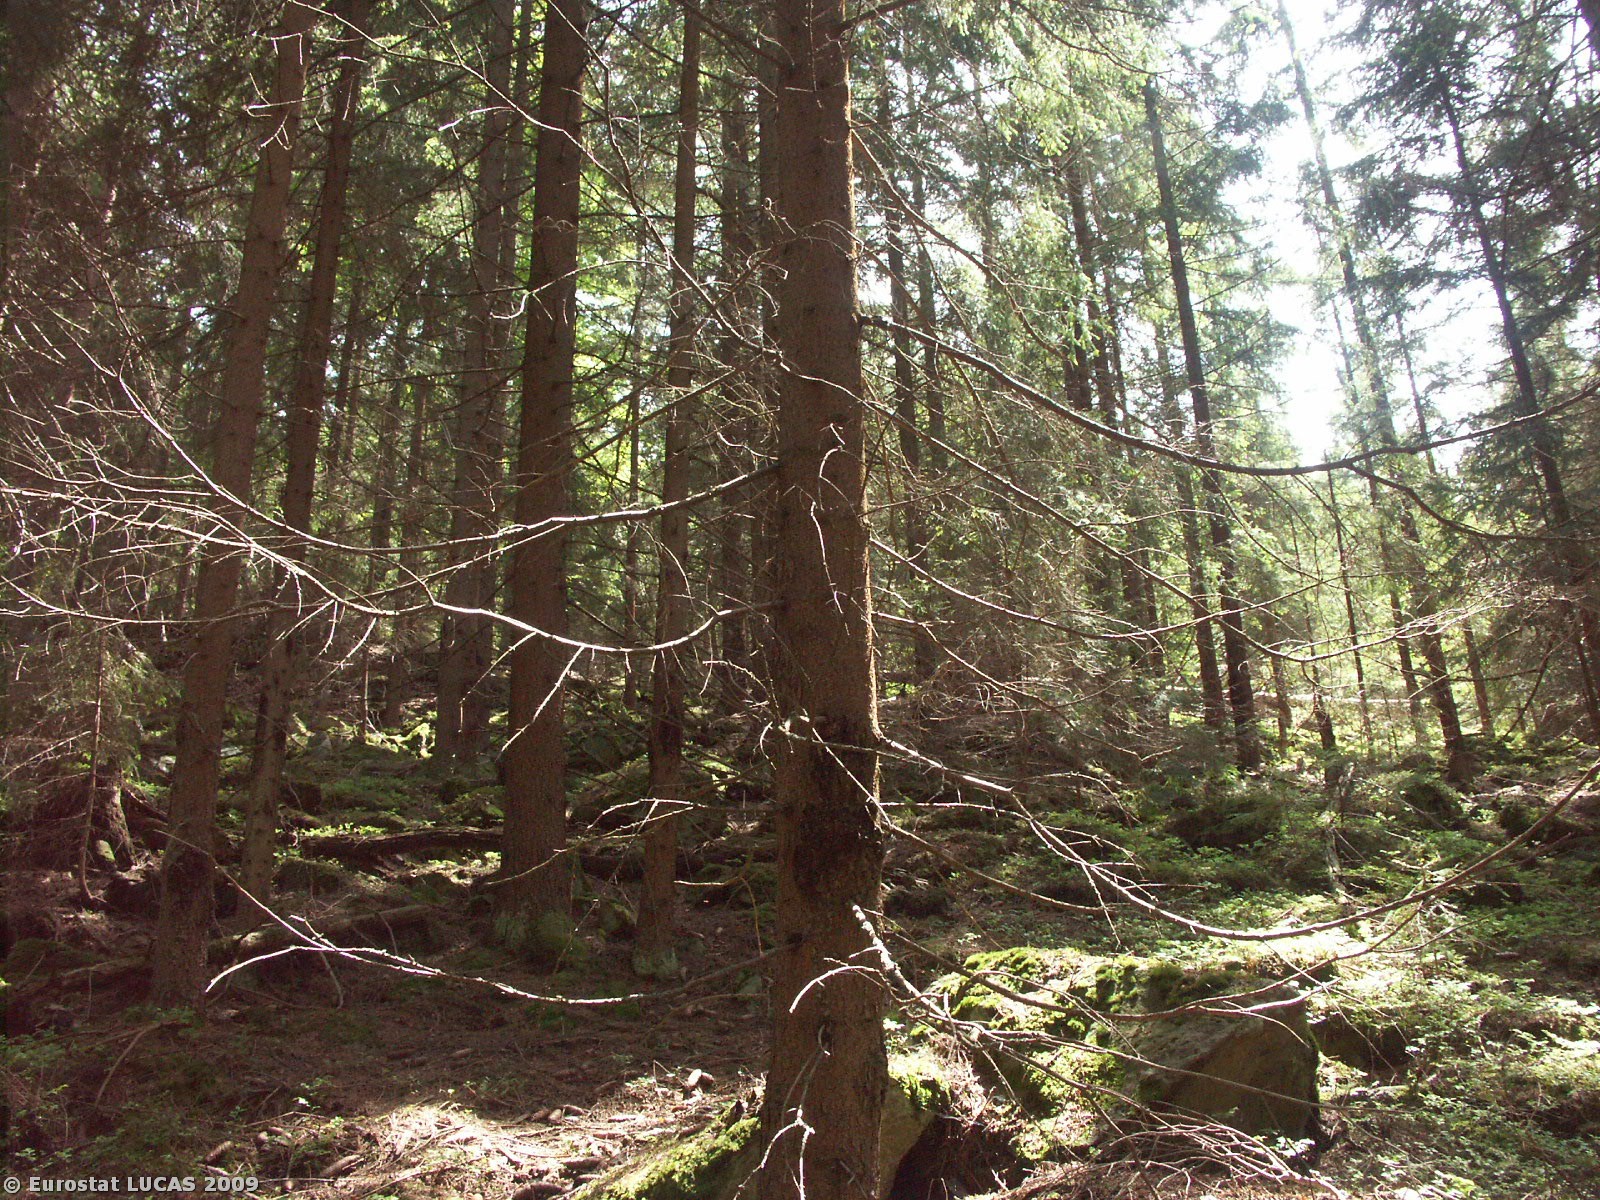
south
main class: Woodland
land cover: Coniferous woodland
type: hemiboreal forest and nemoral coniferous forest and mixed broadleaved-coniferous forest
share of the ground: > 75 %
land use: Forestry
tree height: > 5 m
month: May
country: CZ
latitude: 48.7028
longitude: 14.6346
